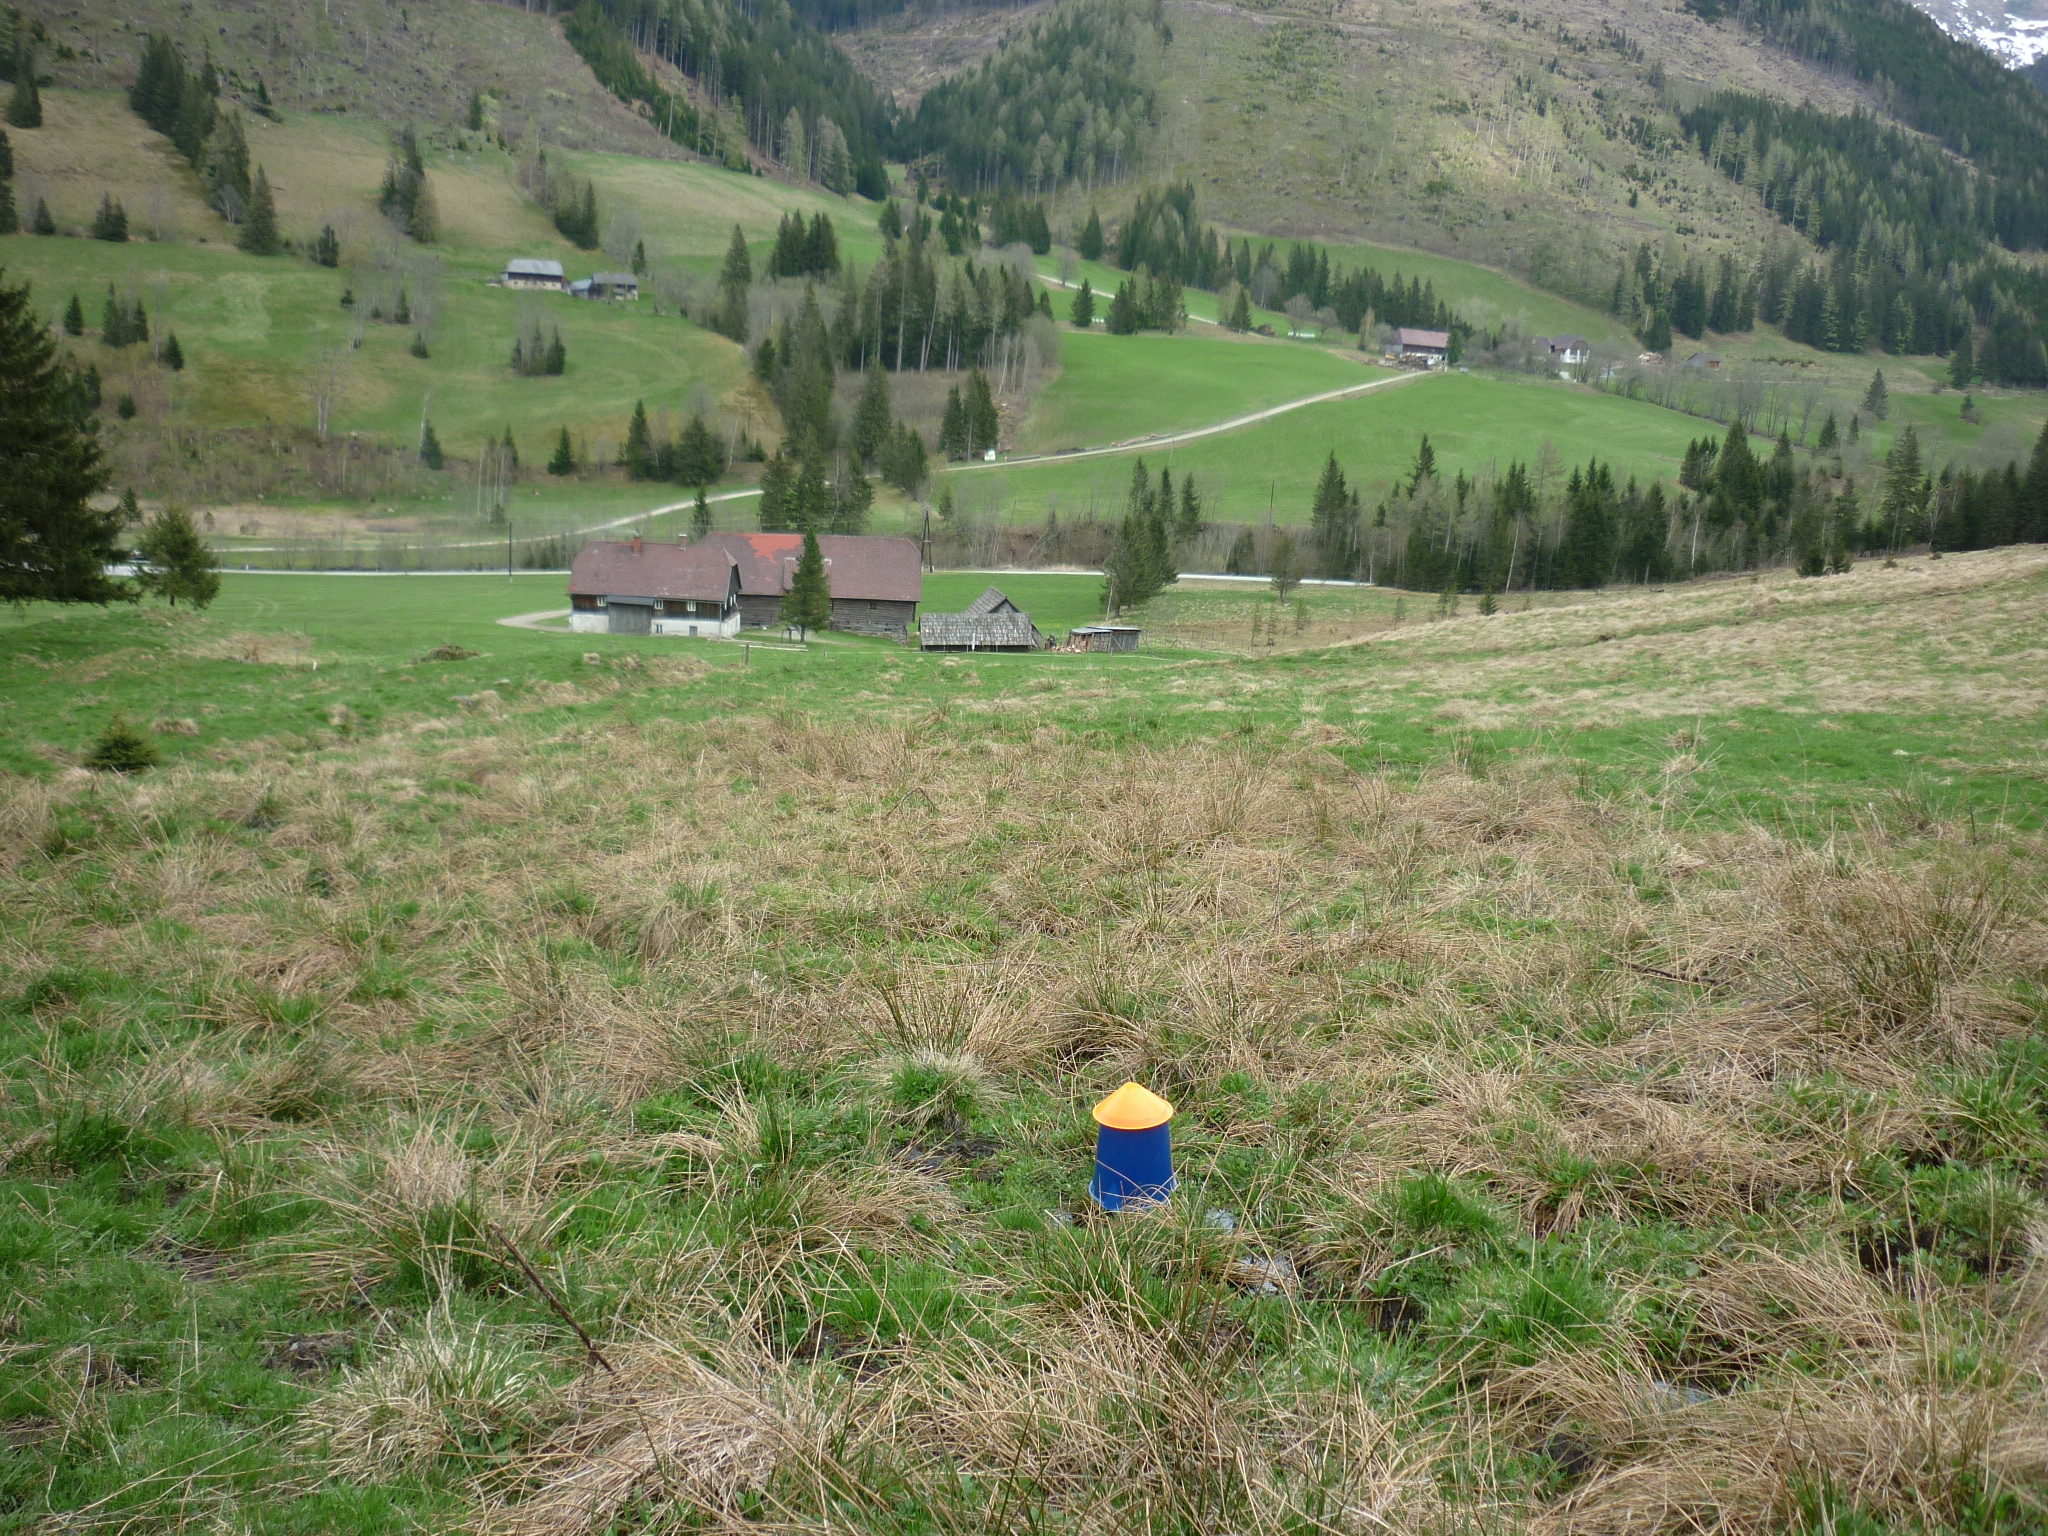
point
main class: Grassland
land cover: Grassland without tree/shrub cover
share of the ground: > 75 %
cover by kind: herbaceous plants 95 %
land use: Agriculture (excluding fallow land and kitchen gardens)
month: May
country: AT
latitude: 47.4555
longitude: 14.2831
